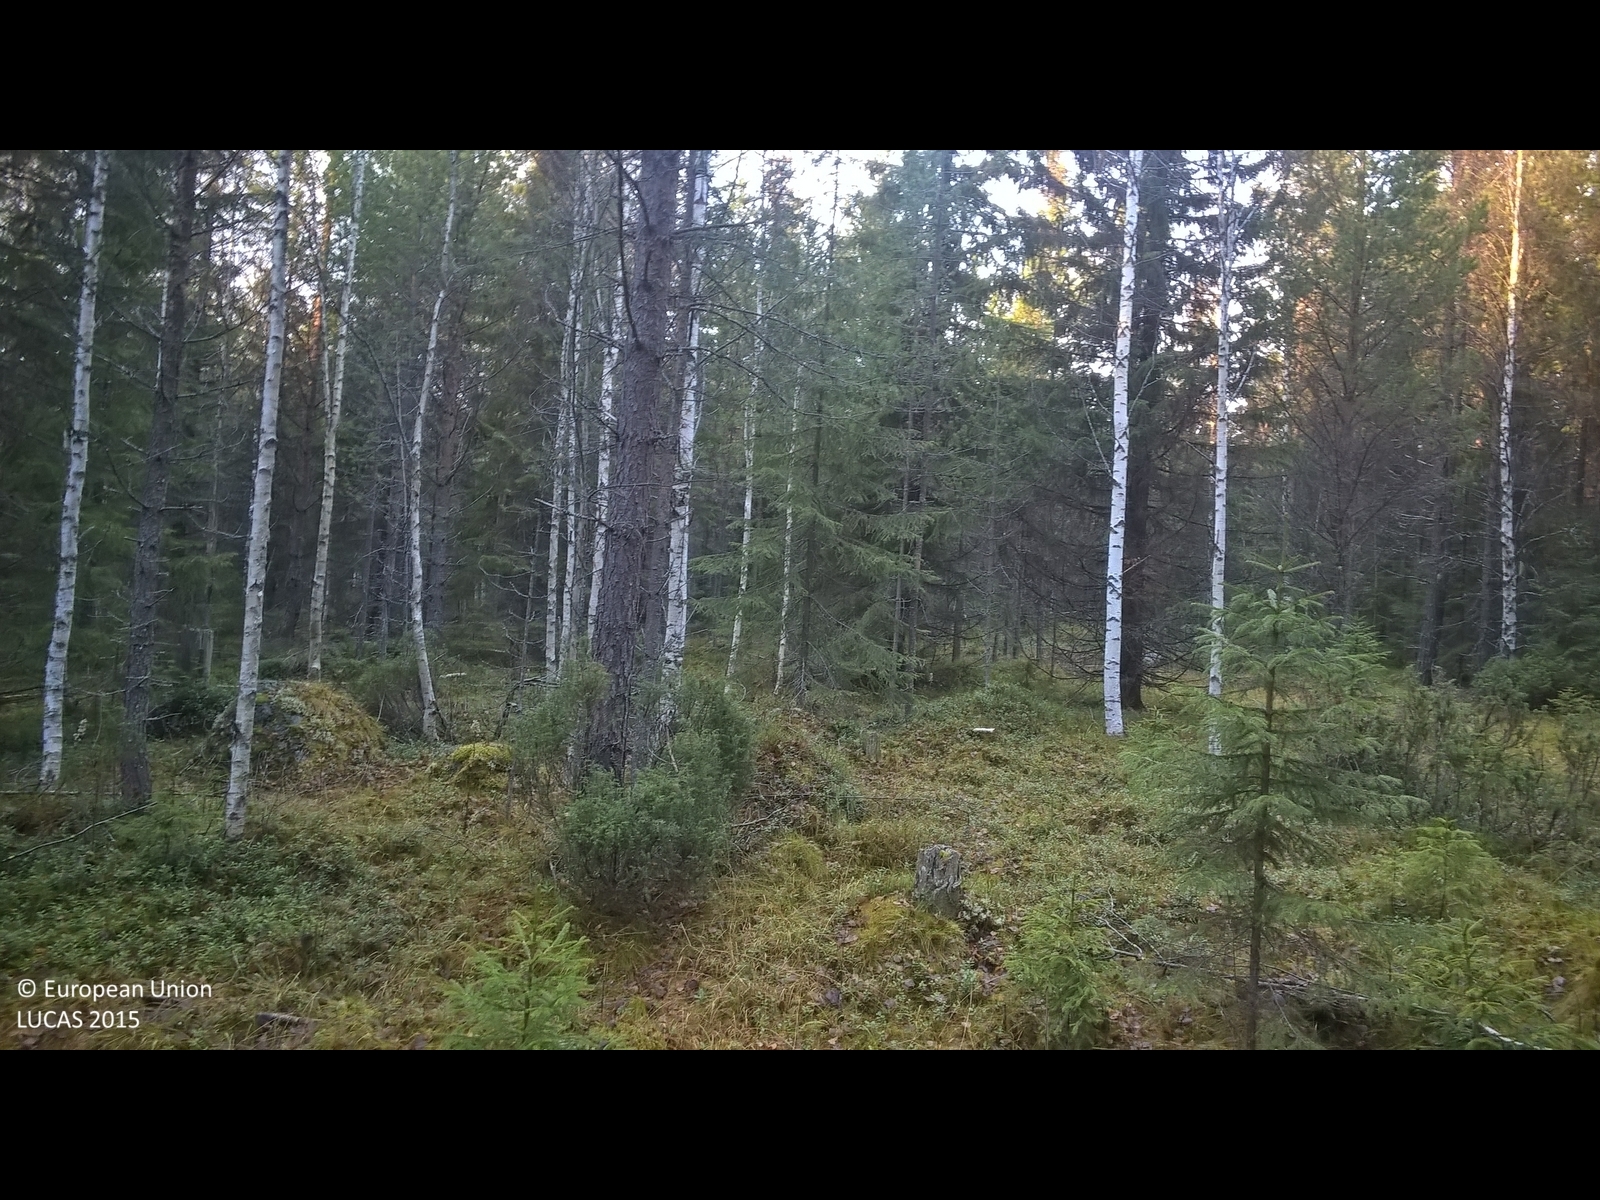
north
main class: Woodland
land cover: Spruce dominated mixed woodland
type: boreal forest
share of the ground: > 75 %
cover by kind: coniferous forest trees 40 %, broadleaved forest trees 40 %, lichens and mosses 20 %
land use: Forestry
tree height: > 5 m
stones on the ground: < 10 %
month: November
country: SE
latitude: 62.7599
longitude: 15.6379
